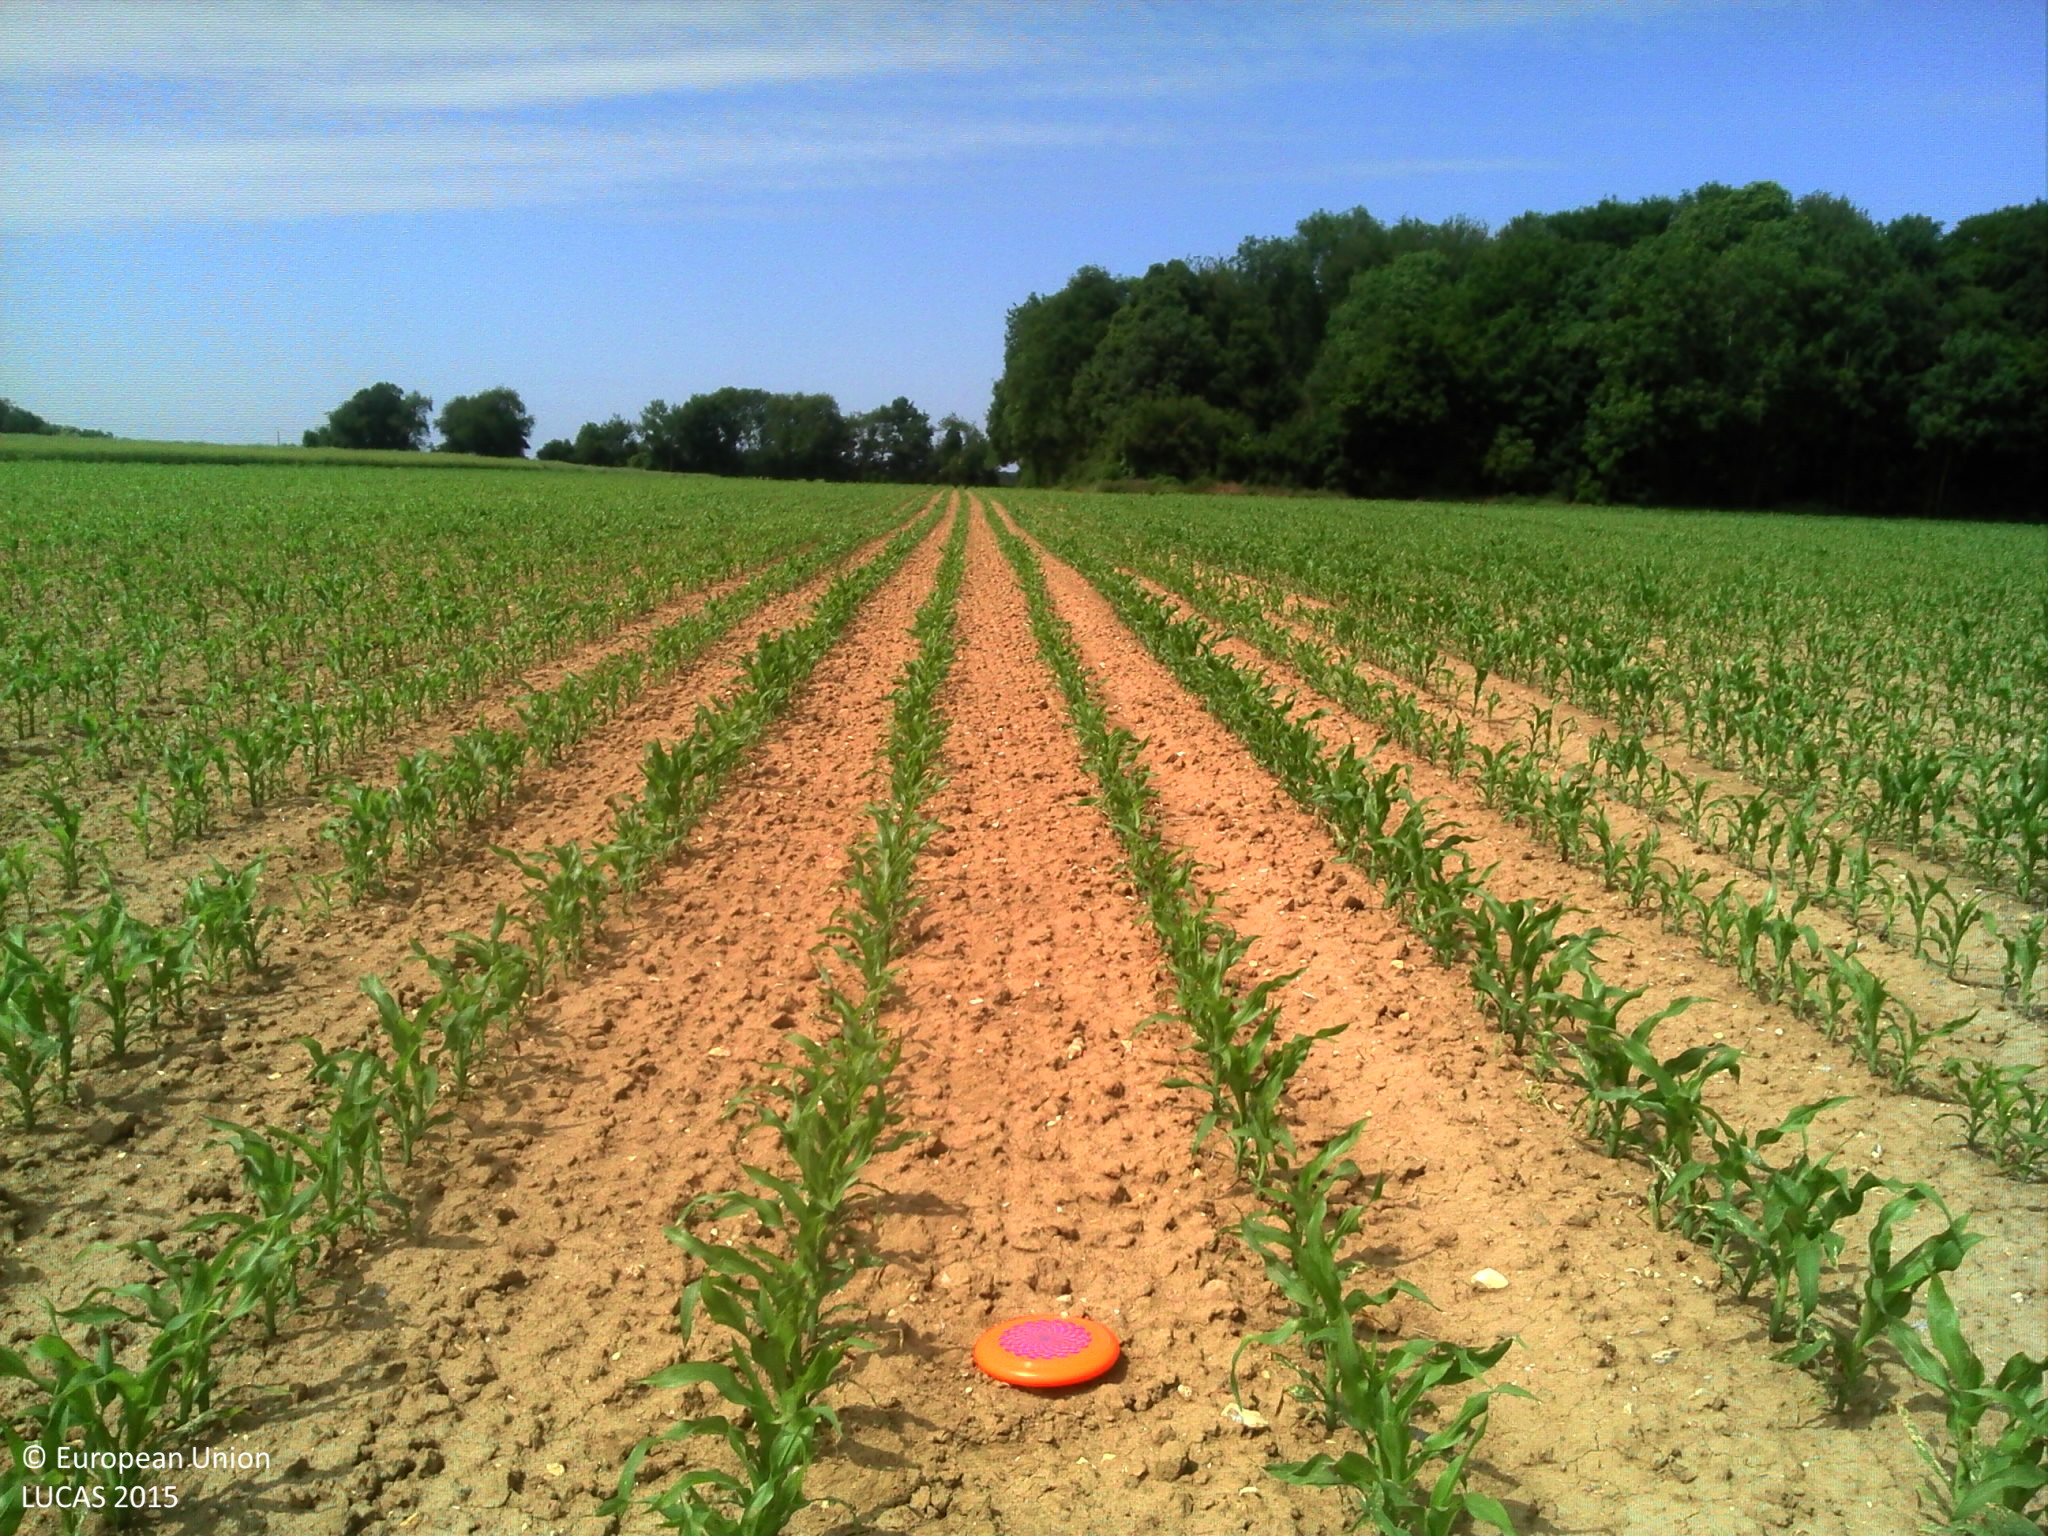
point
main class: Cropland
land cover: Maize
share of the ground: 25 - 50 %
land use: Agriculture (excluding fallow land and kitchen gardens)
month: June
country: FR
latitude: 49.7617
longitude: 2.3097
